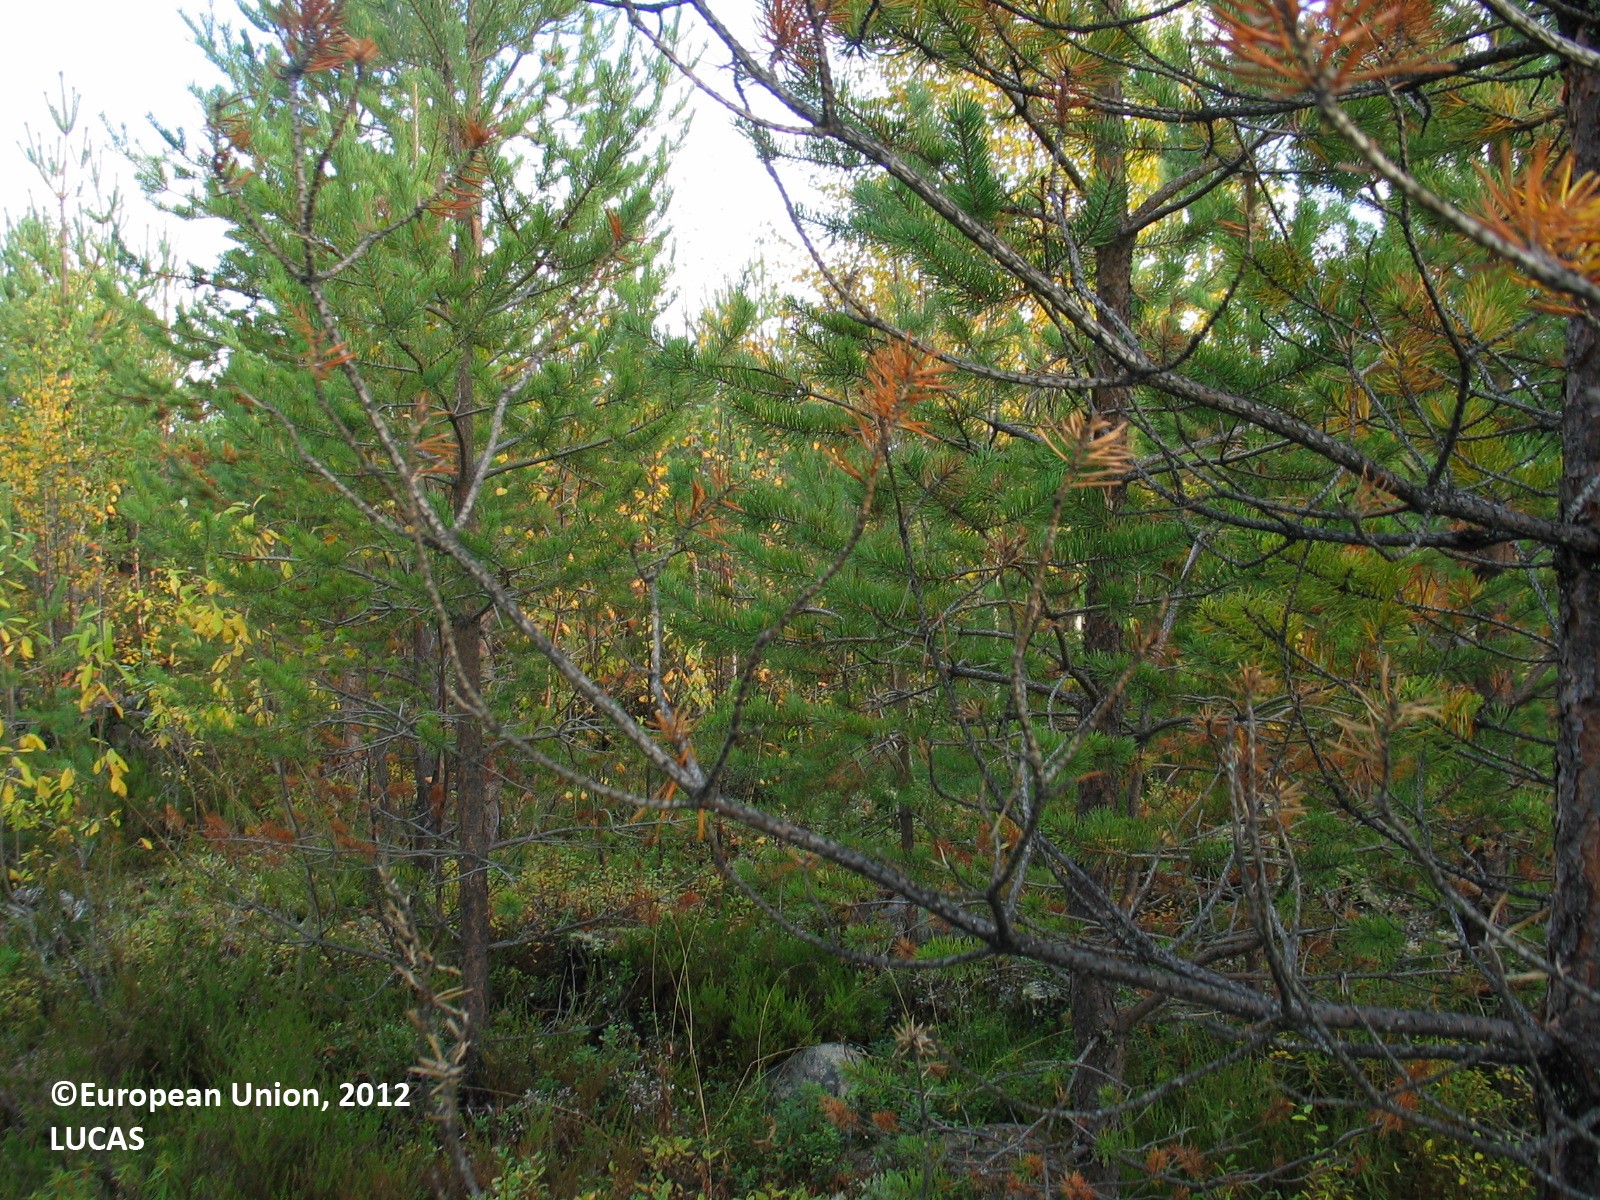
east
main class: Woodland
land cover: Pine dominated coniferous woodland
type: boreal forest
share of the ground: 25 - 50 %
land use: Forestry
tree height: < 5 m
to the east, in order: Pine dominated coniferous woodland; Ditches and canals; Groves; Tracks; Pine dominated coniferous woodland; Ditches and canals; Pine dominated coniferous woodland; Ditches and canals; Pine dominated coniferous woodland; Ditches and canals; Abandoned hedges; Tracks; Pine dominated coniferous woodland; Ditches and canals; Pine dominated coniferous woodland
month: September
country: FI
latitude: 65.3744
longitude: 25.6323
